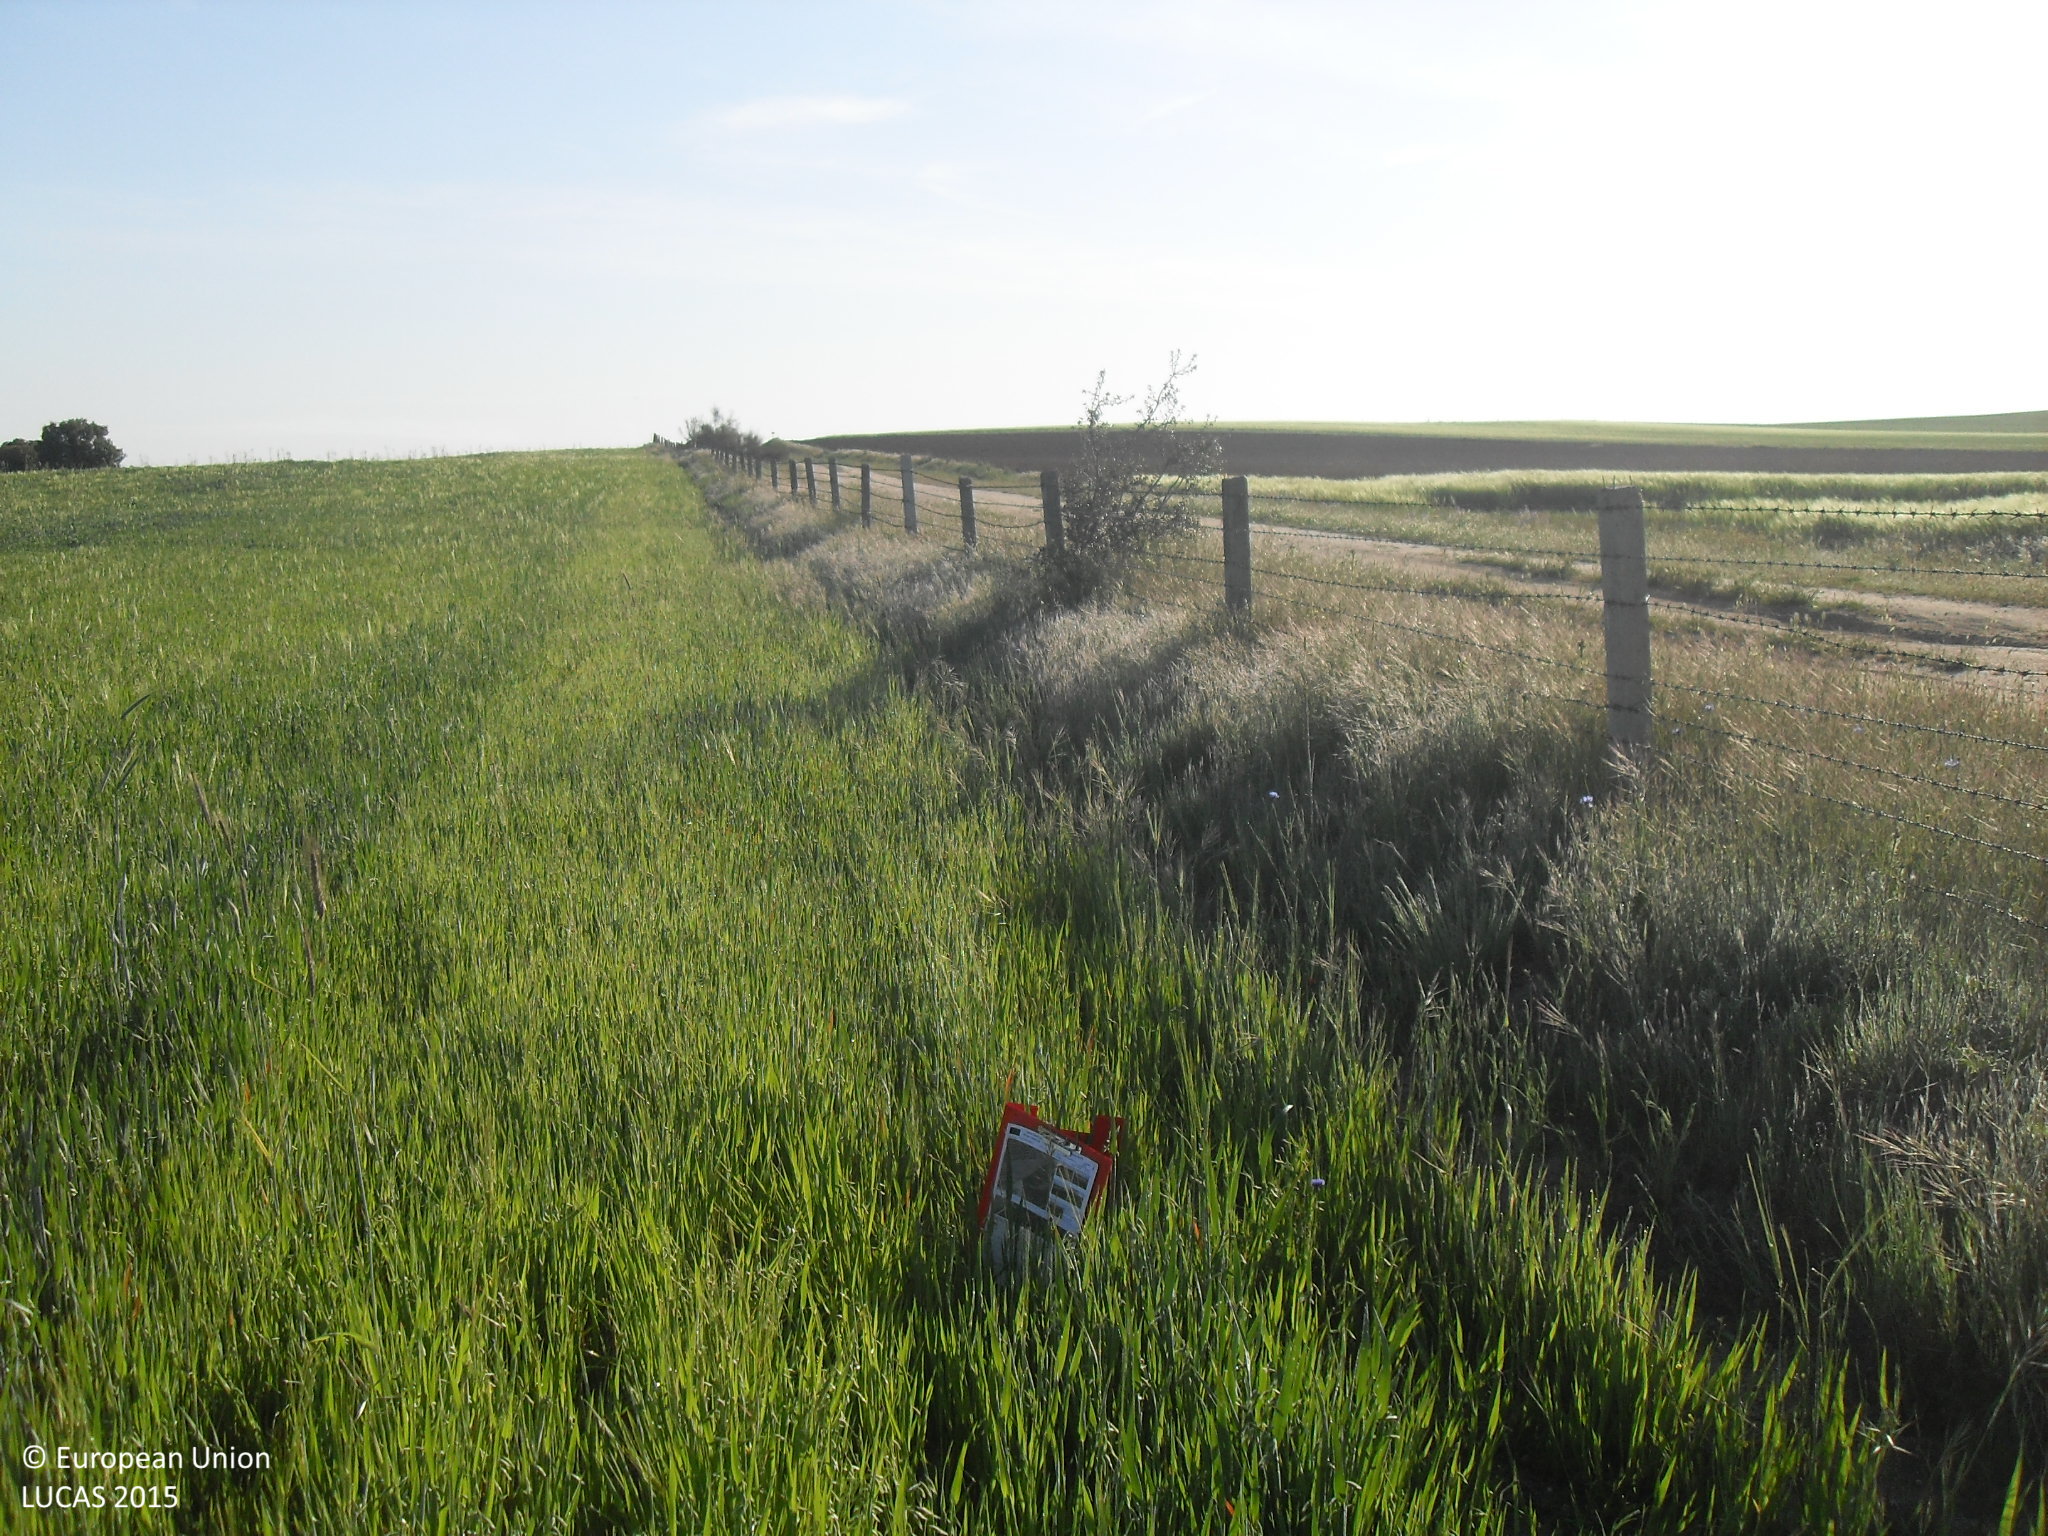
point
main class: Cropland
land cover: Oats
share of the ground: > 75 %
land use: Agriculture (excluding fallow land and kitchen gardens)
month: May
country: ES
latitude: 40.9002
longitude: -5.2752
